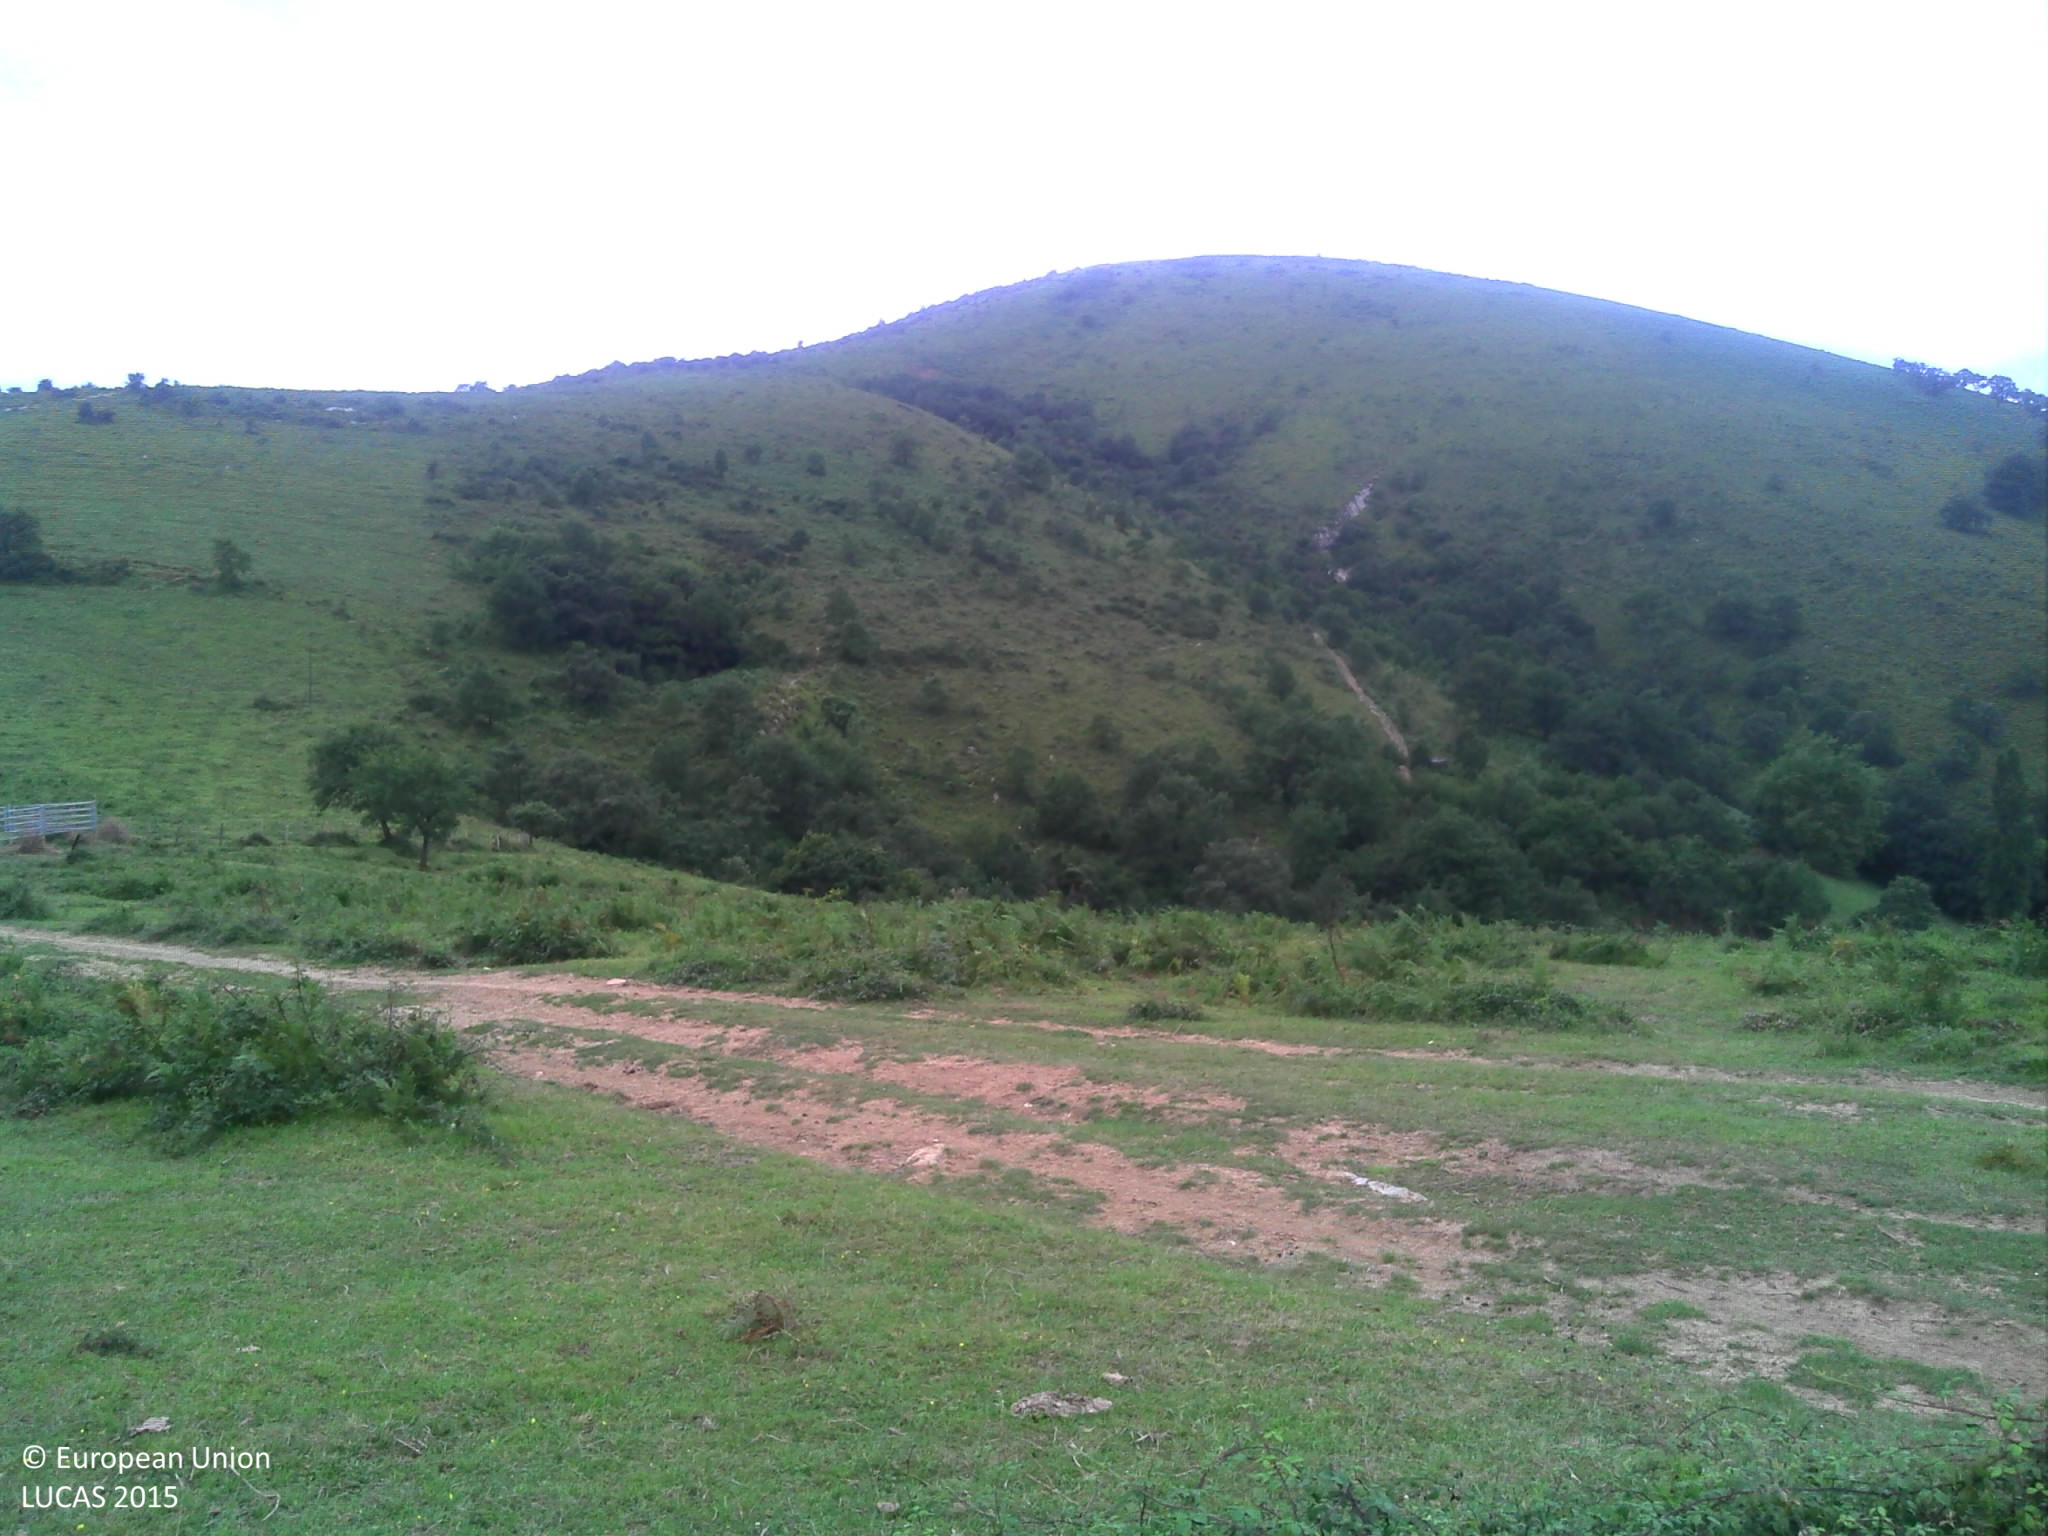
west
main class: Grassland
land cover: Grassland without tree/shrub cover
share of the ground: > 75 %
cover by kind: herbaceous plants 95 %, shrubs 5 %
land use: Agriculture (excluding fallow land and kitchen gardens)
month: August
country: FR
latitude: 43.2552
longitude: -1.1610
